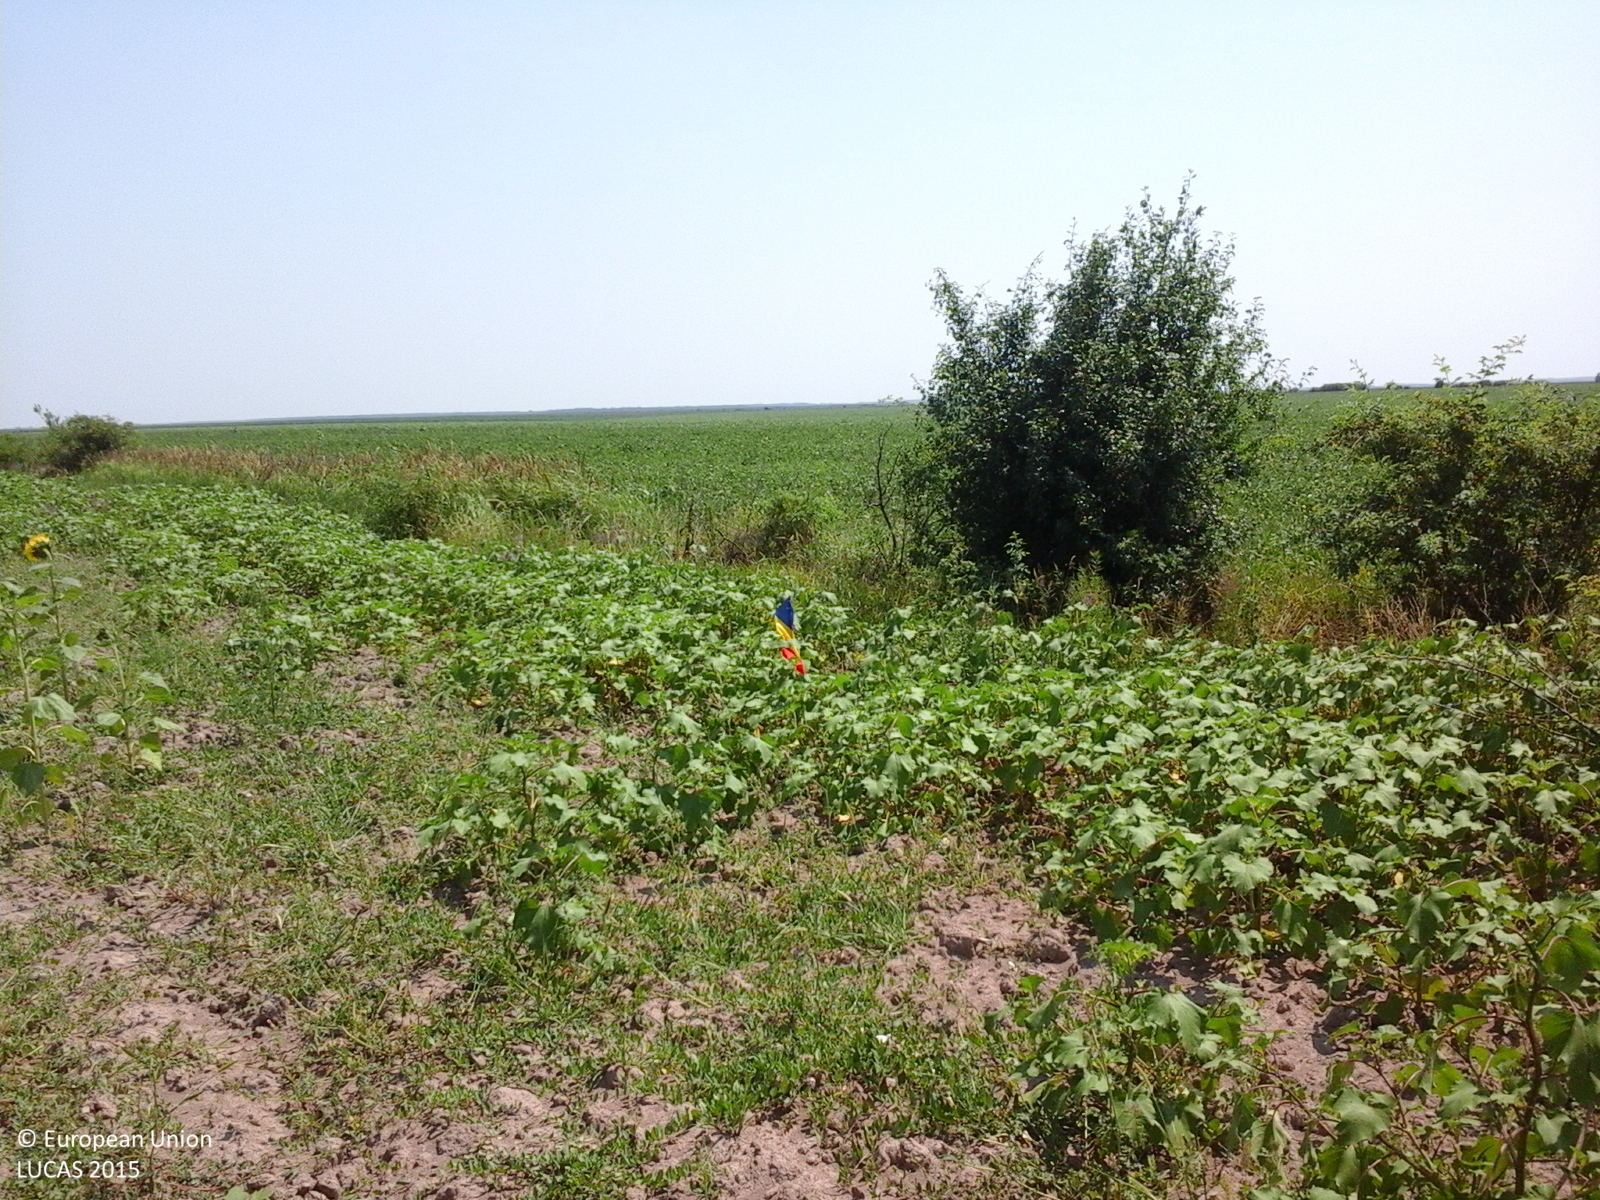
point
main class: Grassland
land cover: Spontaneously vegetated surfaces
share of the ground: > 75 %
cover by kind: herbaceous plants 100 %
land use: Fallow land
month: July
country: RO
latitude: 44.7720
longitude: 25.6267
